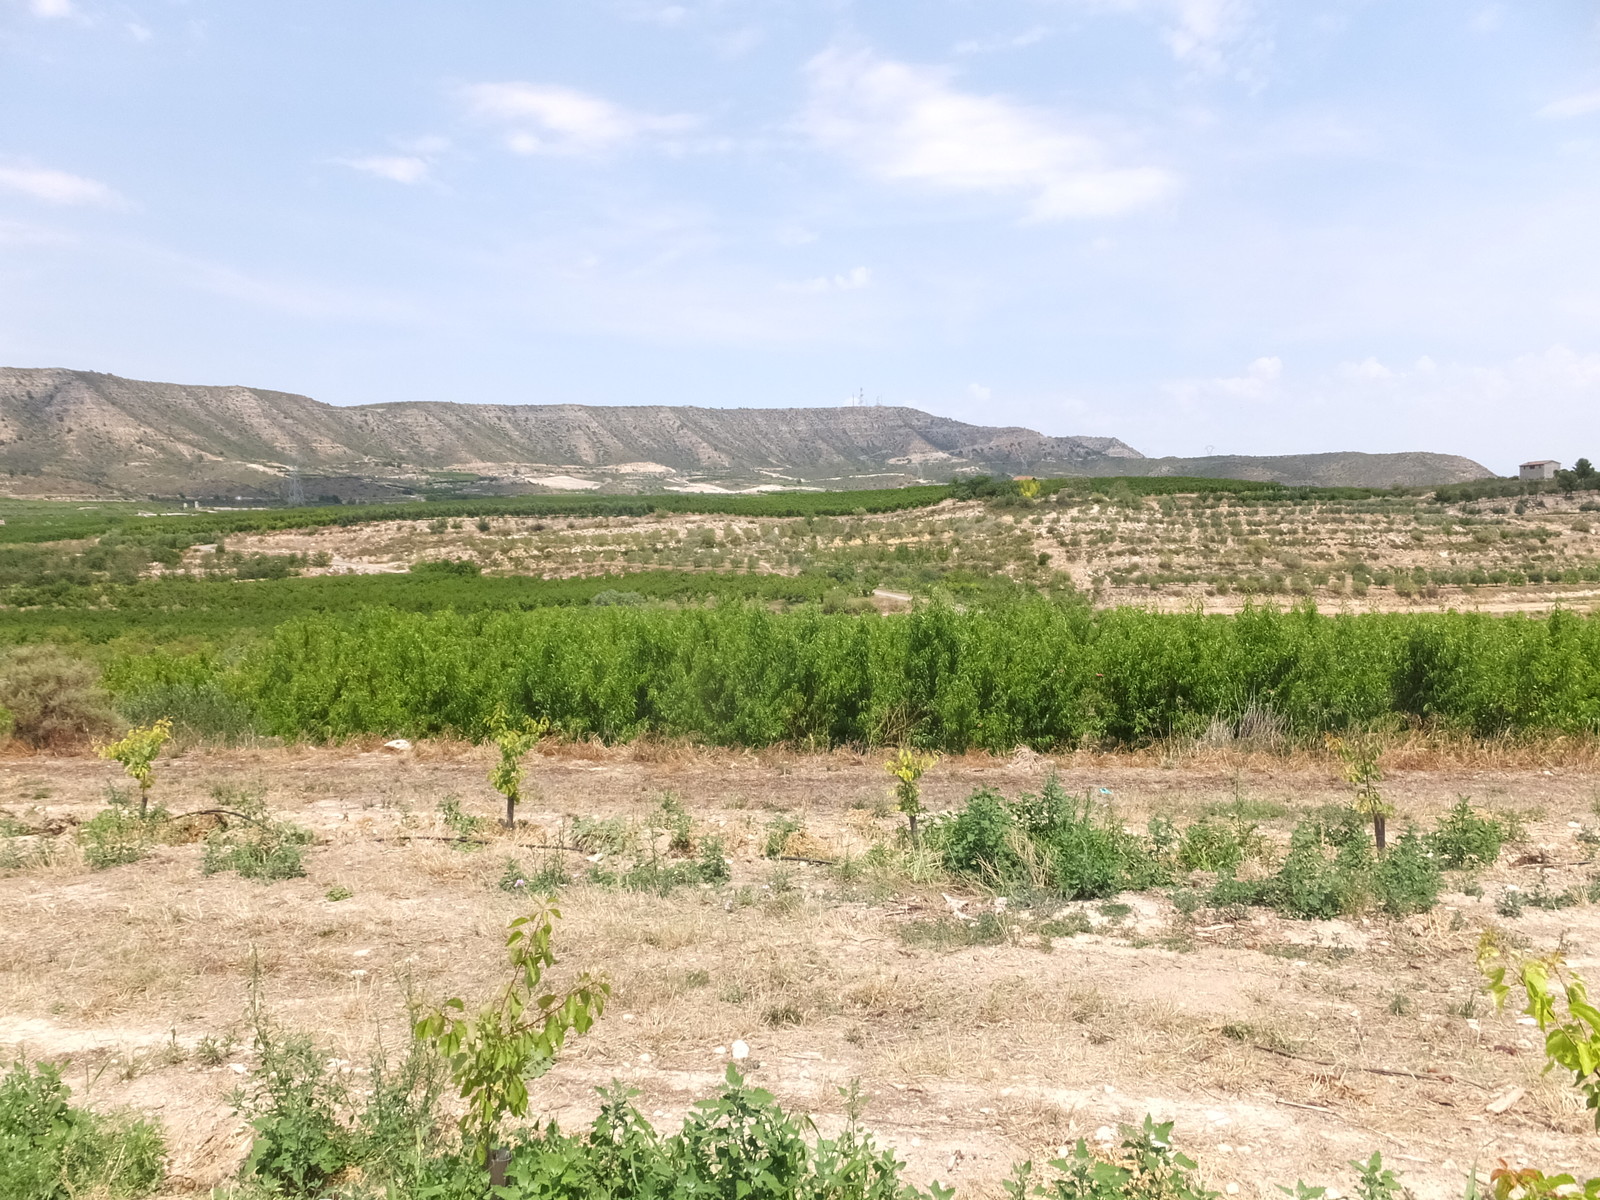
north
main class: Cropland
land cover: Other fruit trees and berries
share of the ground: 10 - 25 %
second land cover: Spontaneously vegetated surfaces
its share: 50 - 75 %
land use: Agriculture (excluding fallow land and kitchen gardens)
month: June
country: ES
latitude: 41.3684
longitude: 0.2923
